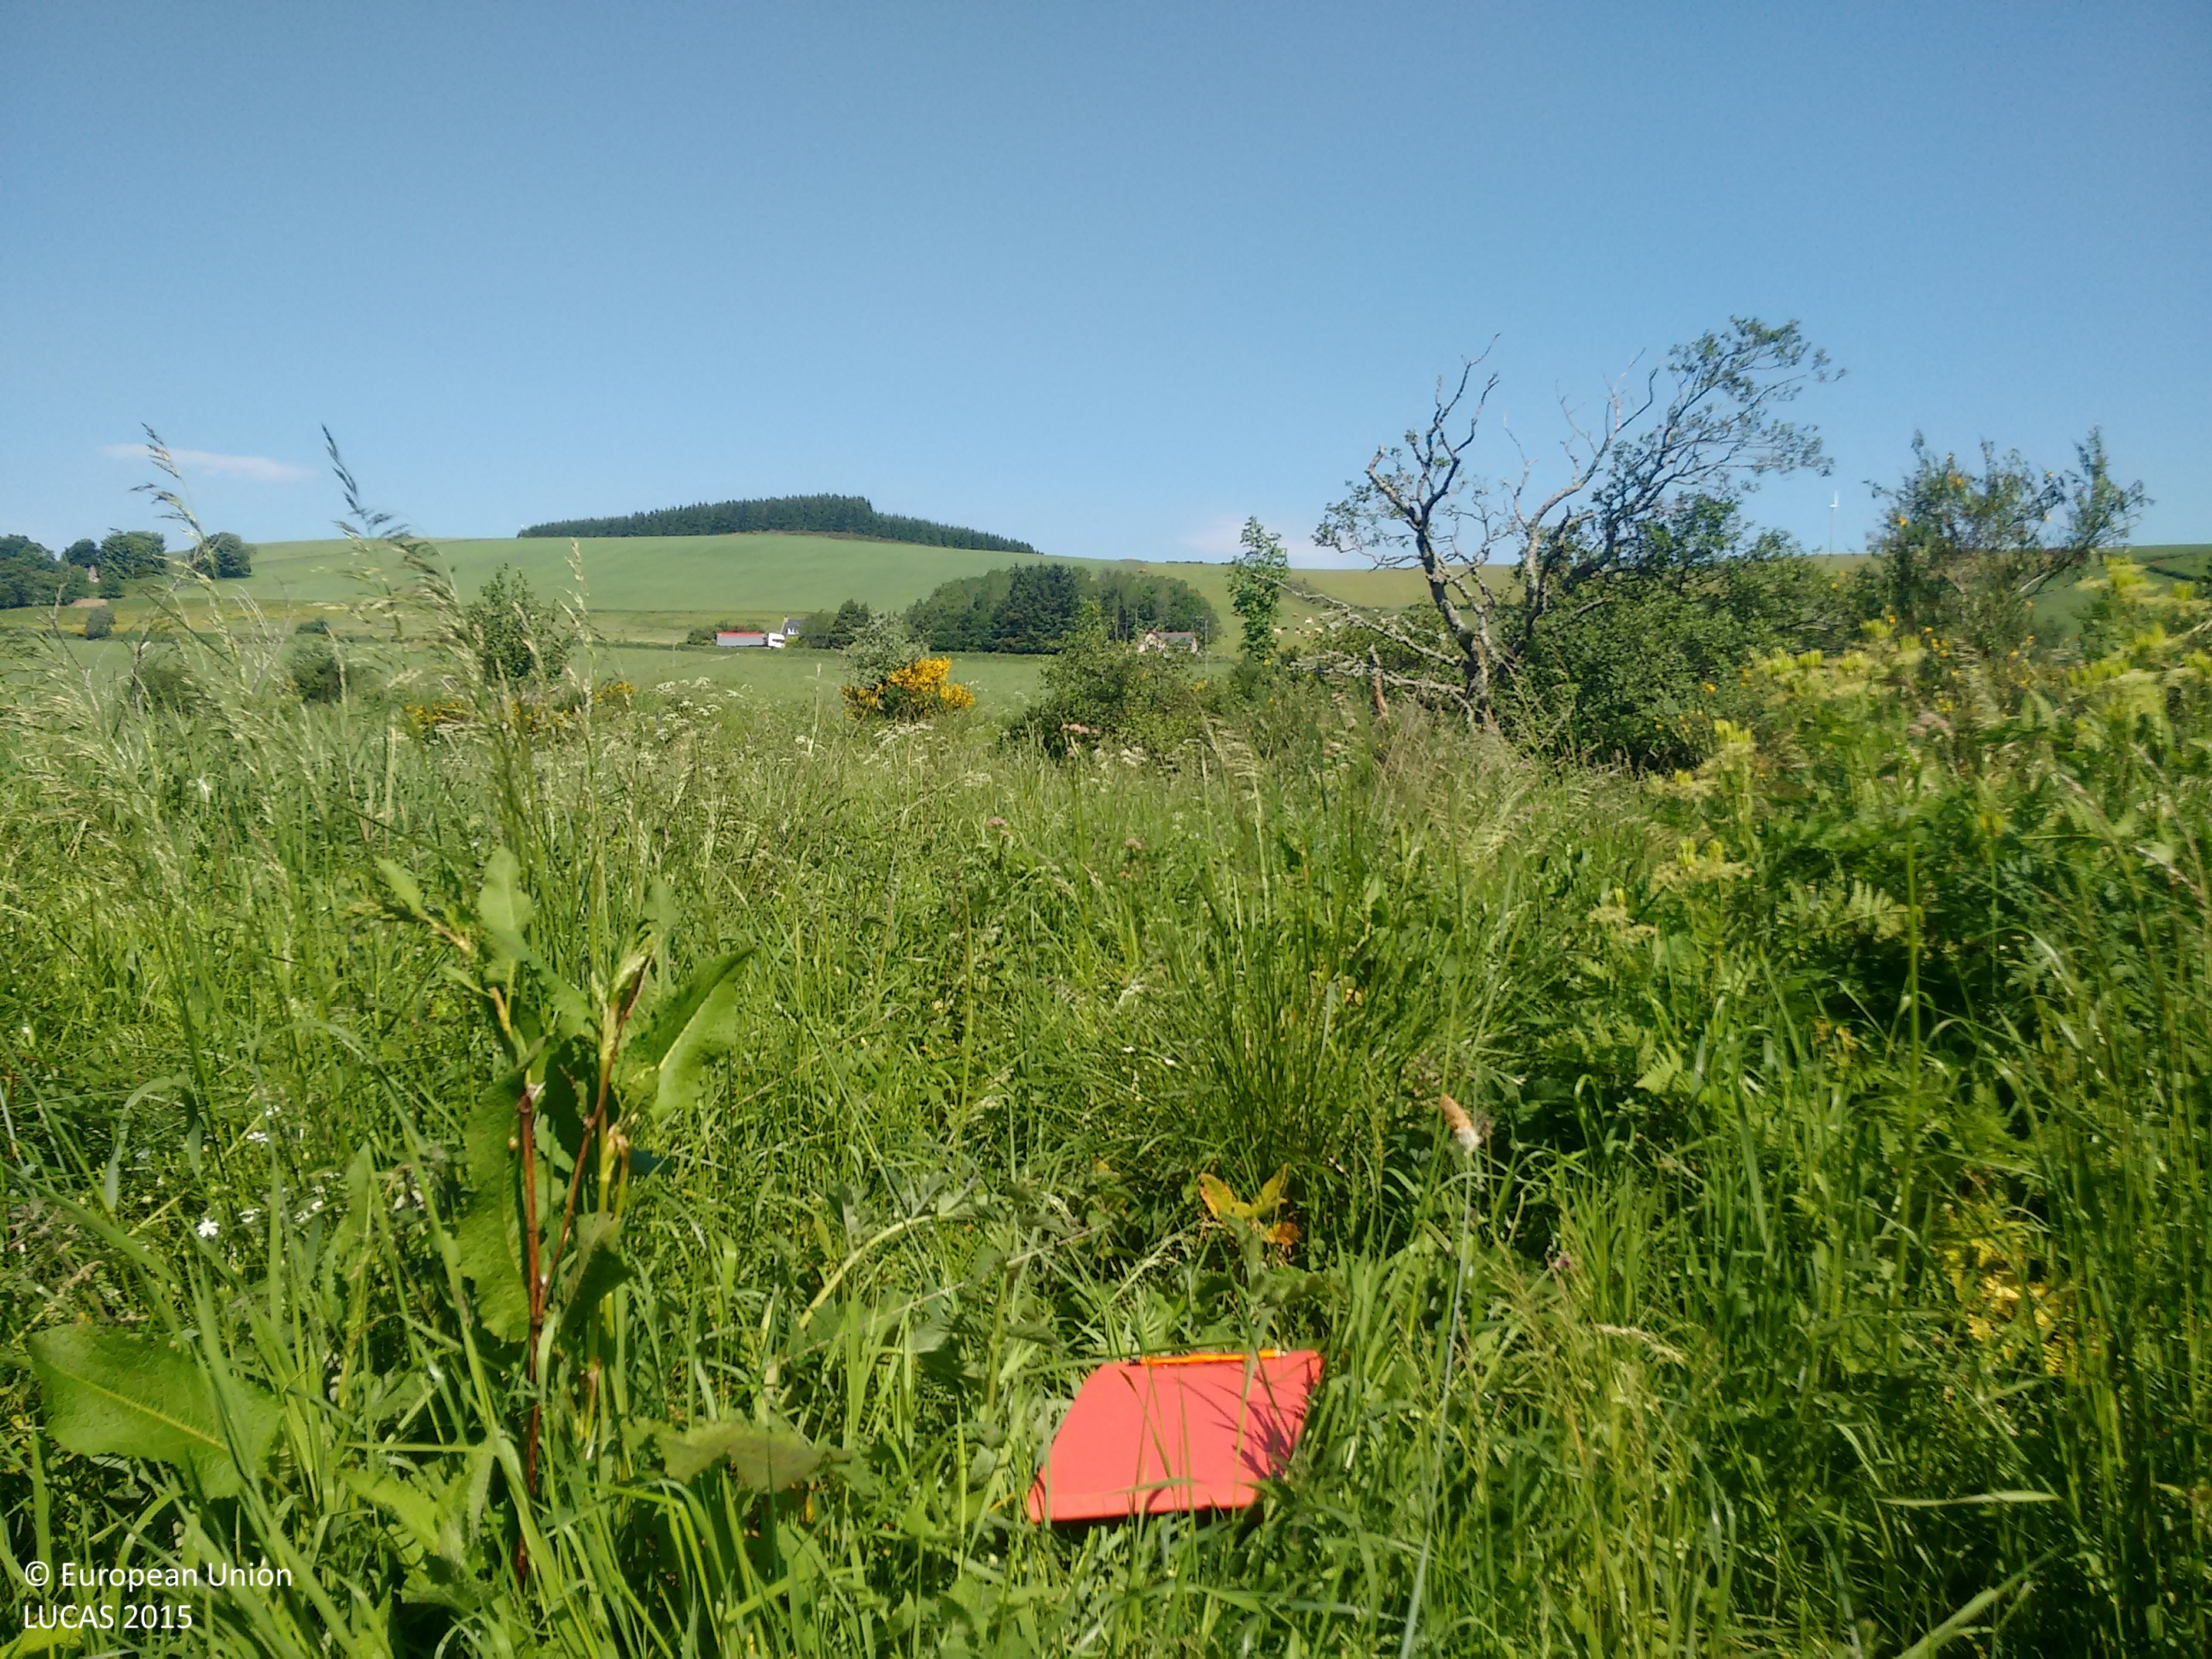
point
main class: Woodland
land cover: Broadleaved woodland
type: mesophytic deciduous forest
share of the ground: > 75 %
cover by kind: herbaceous plants 60 %, broadleaved forest trees 30 %, shrubs 10 %
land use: Semi-natural and natural areas not in use
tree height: > 5 m
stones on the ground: < 10 %
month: July
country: GB
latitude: 57.4509
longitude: -2.8745
